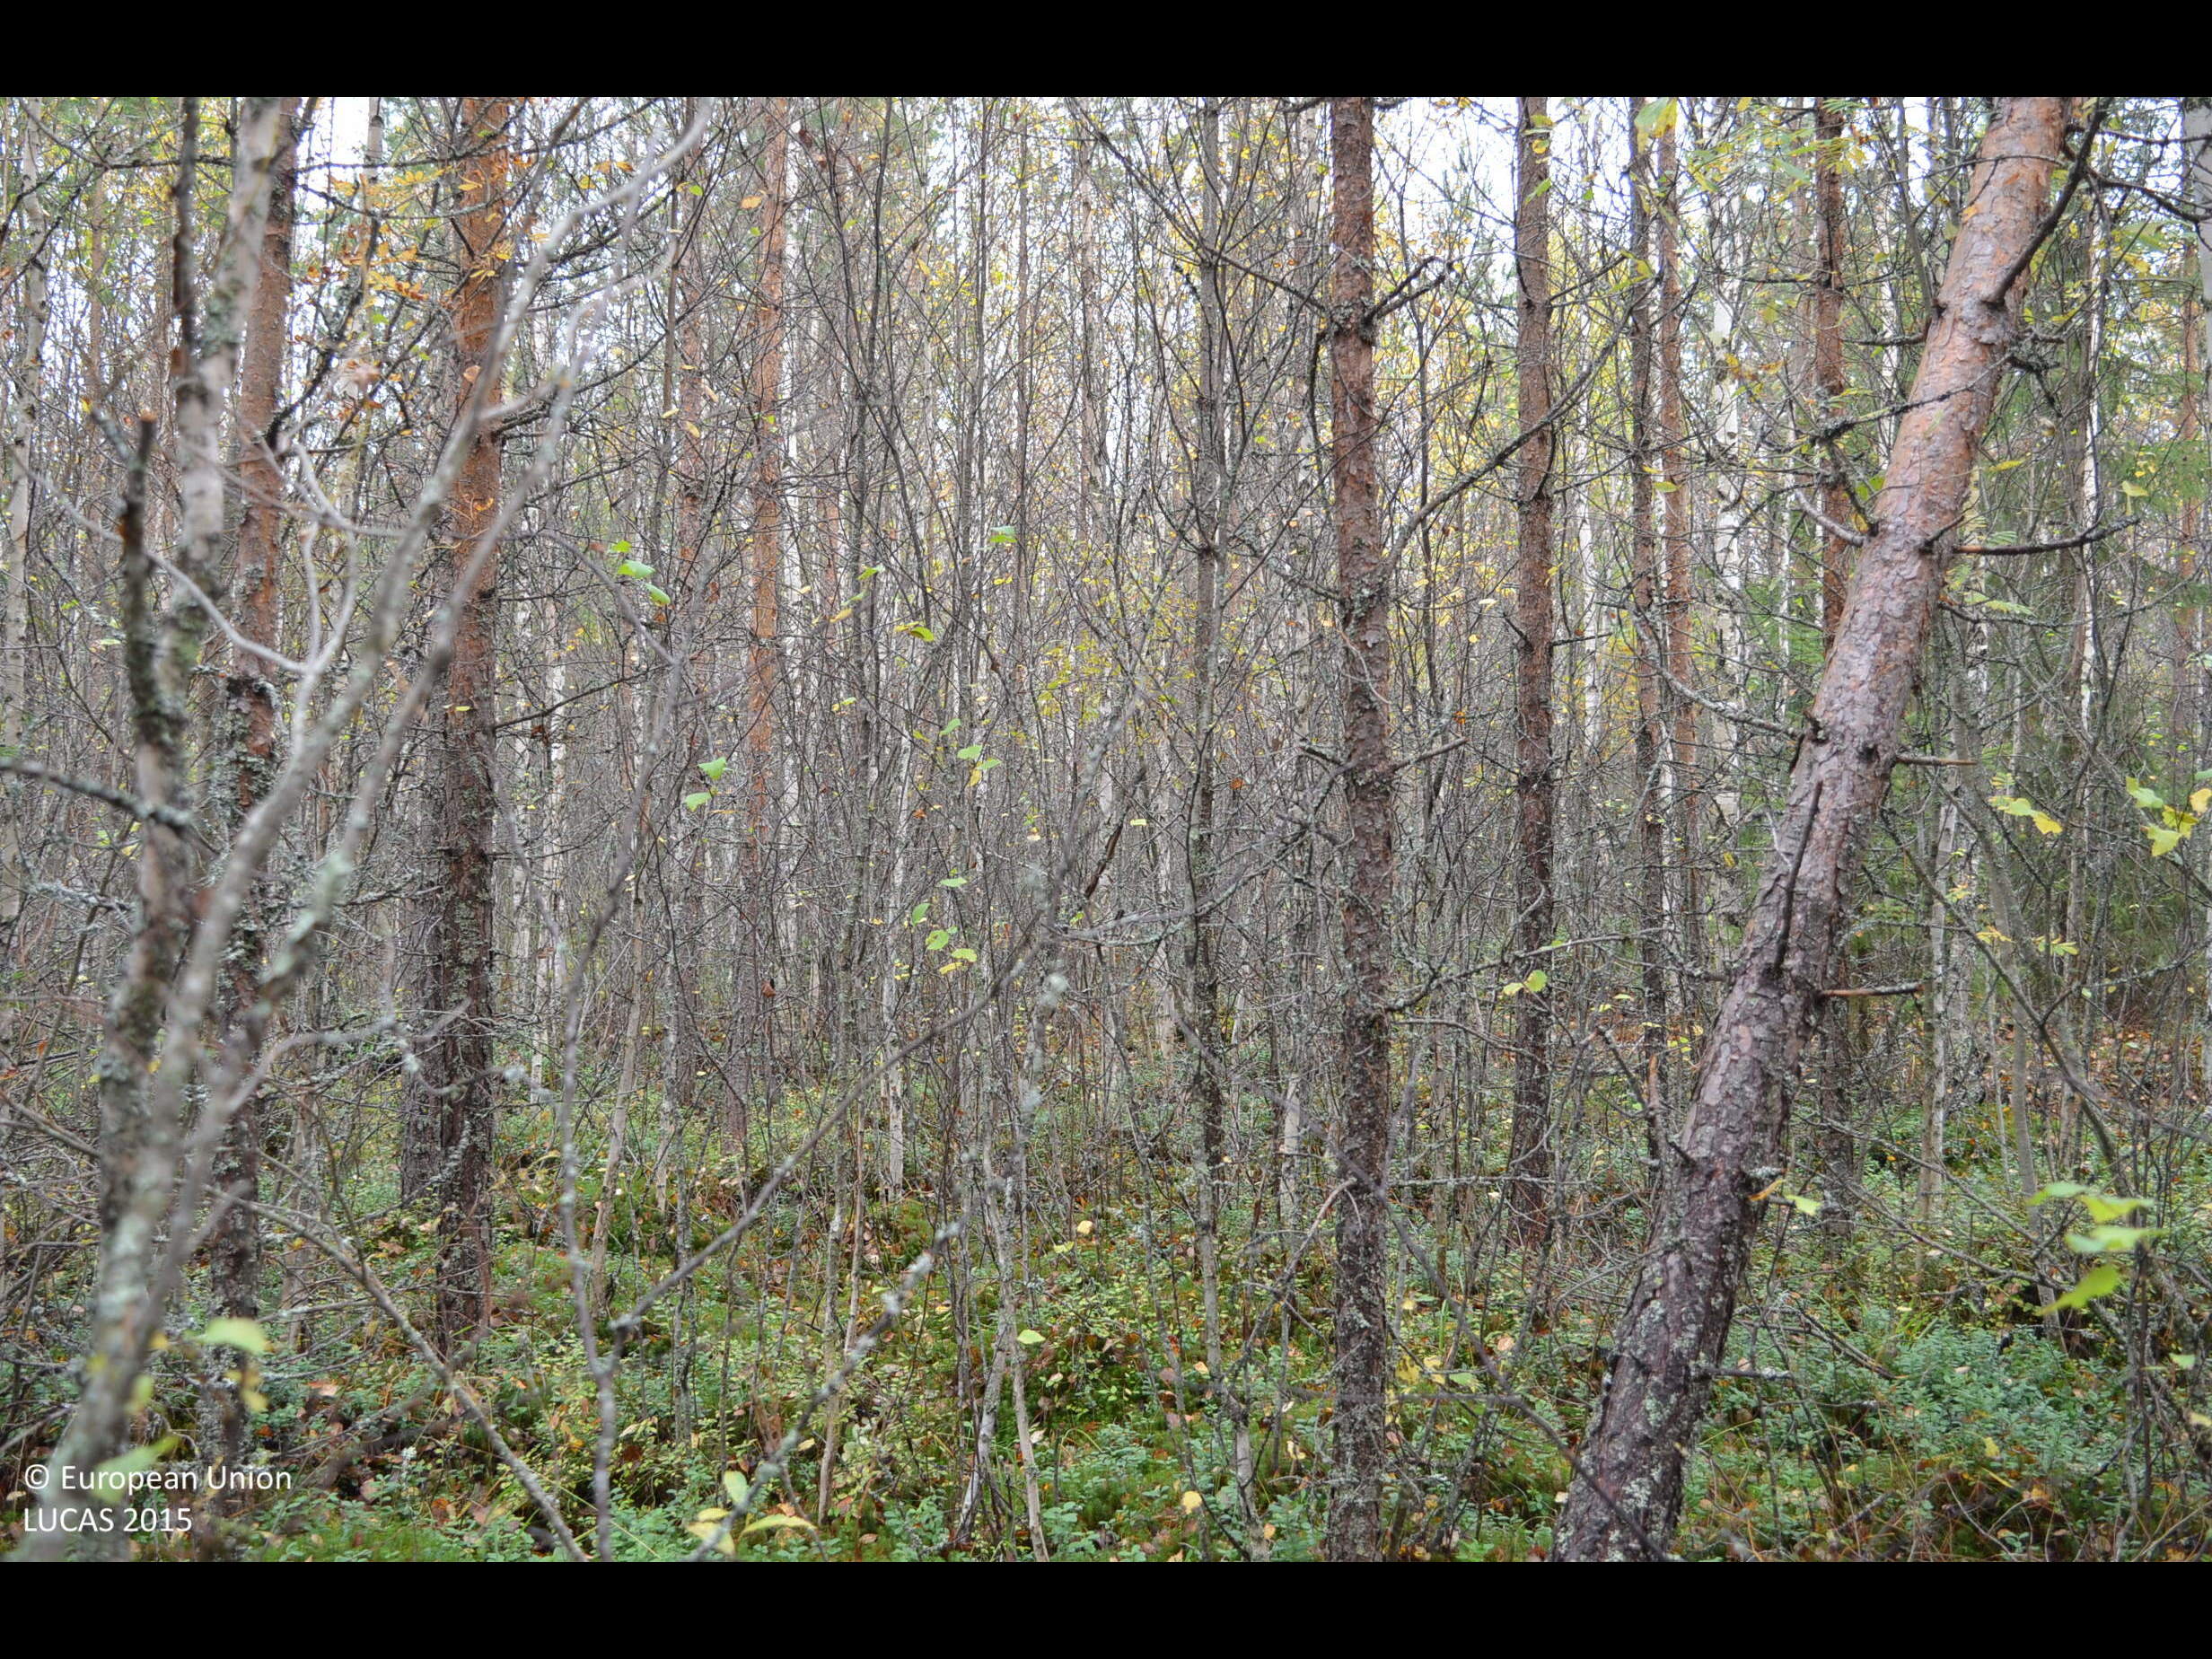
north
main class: Woodland
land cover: Pine dominated mixed woodland
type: boreal forest
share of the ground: > 75 %
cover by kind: broadleaved forest trees 50 %, coniferous forest trees 40 %, shrubs 5 %, lichens and mosses 5 %
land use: Forestry
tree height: > 5 m
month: September
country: FI
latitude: 62.5365
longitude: 23.6595
